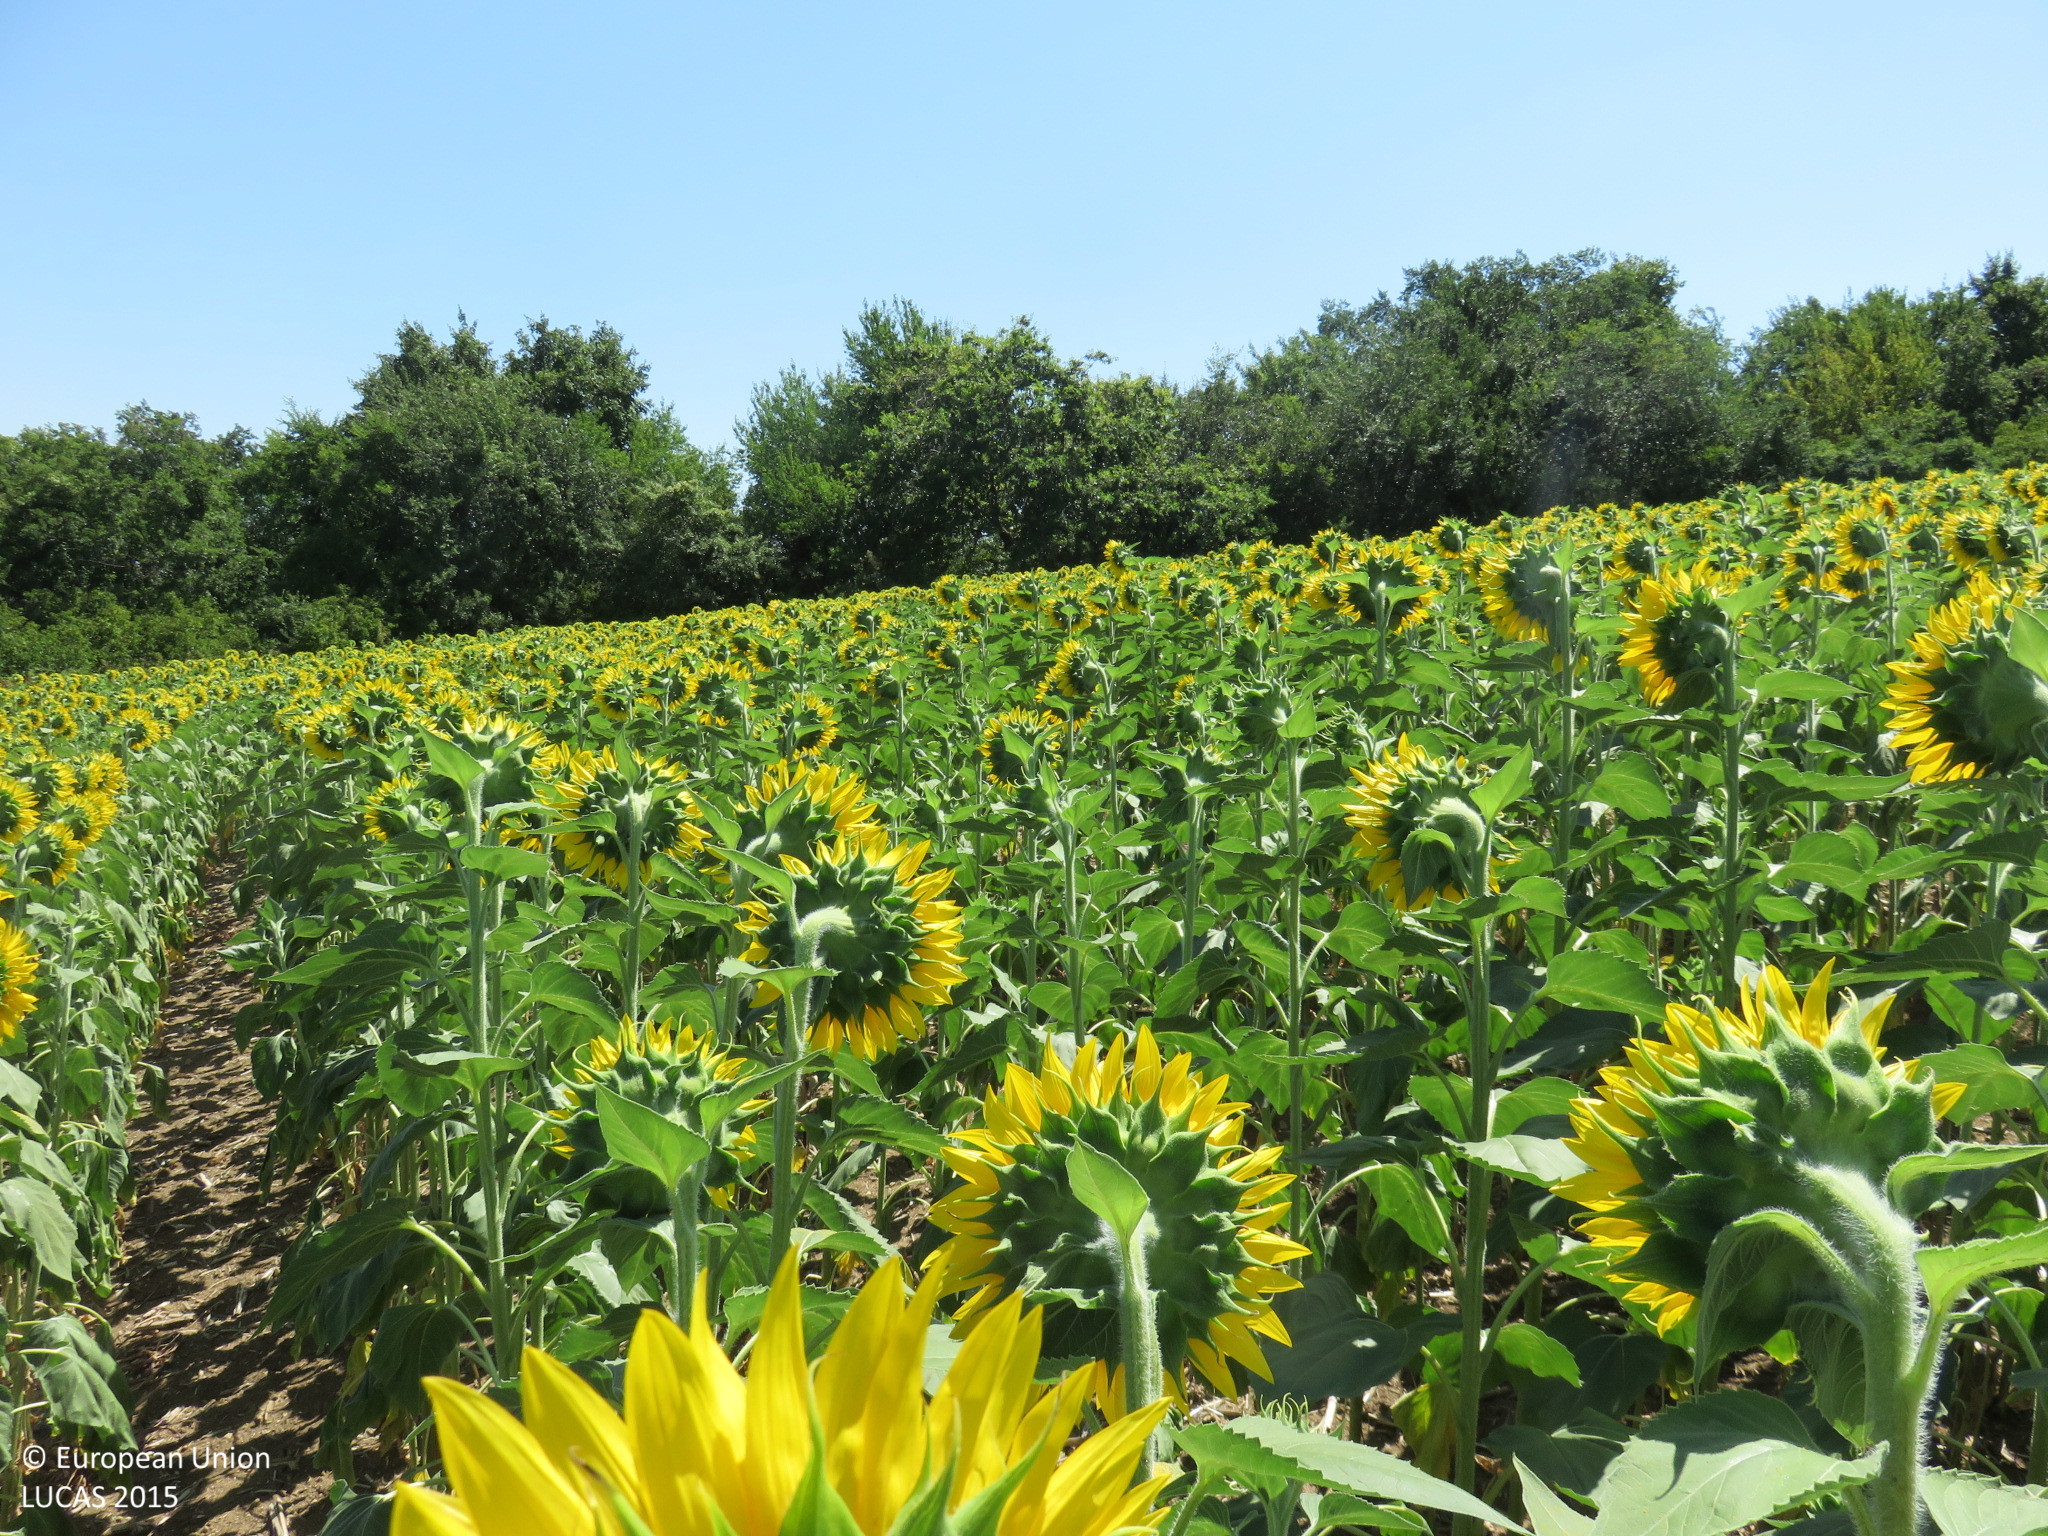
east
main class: Cropland
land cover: Sunflower
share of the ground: > 75 %
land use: Agriculture (excluding fallow land and kitchen gardens)
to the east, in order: Sunflower; Broadleaved woodland; Sunflower; Single bushes/trees; Sunflower
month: July
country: BG
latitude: 43.2407
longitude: 25.0820
